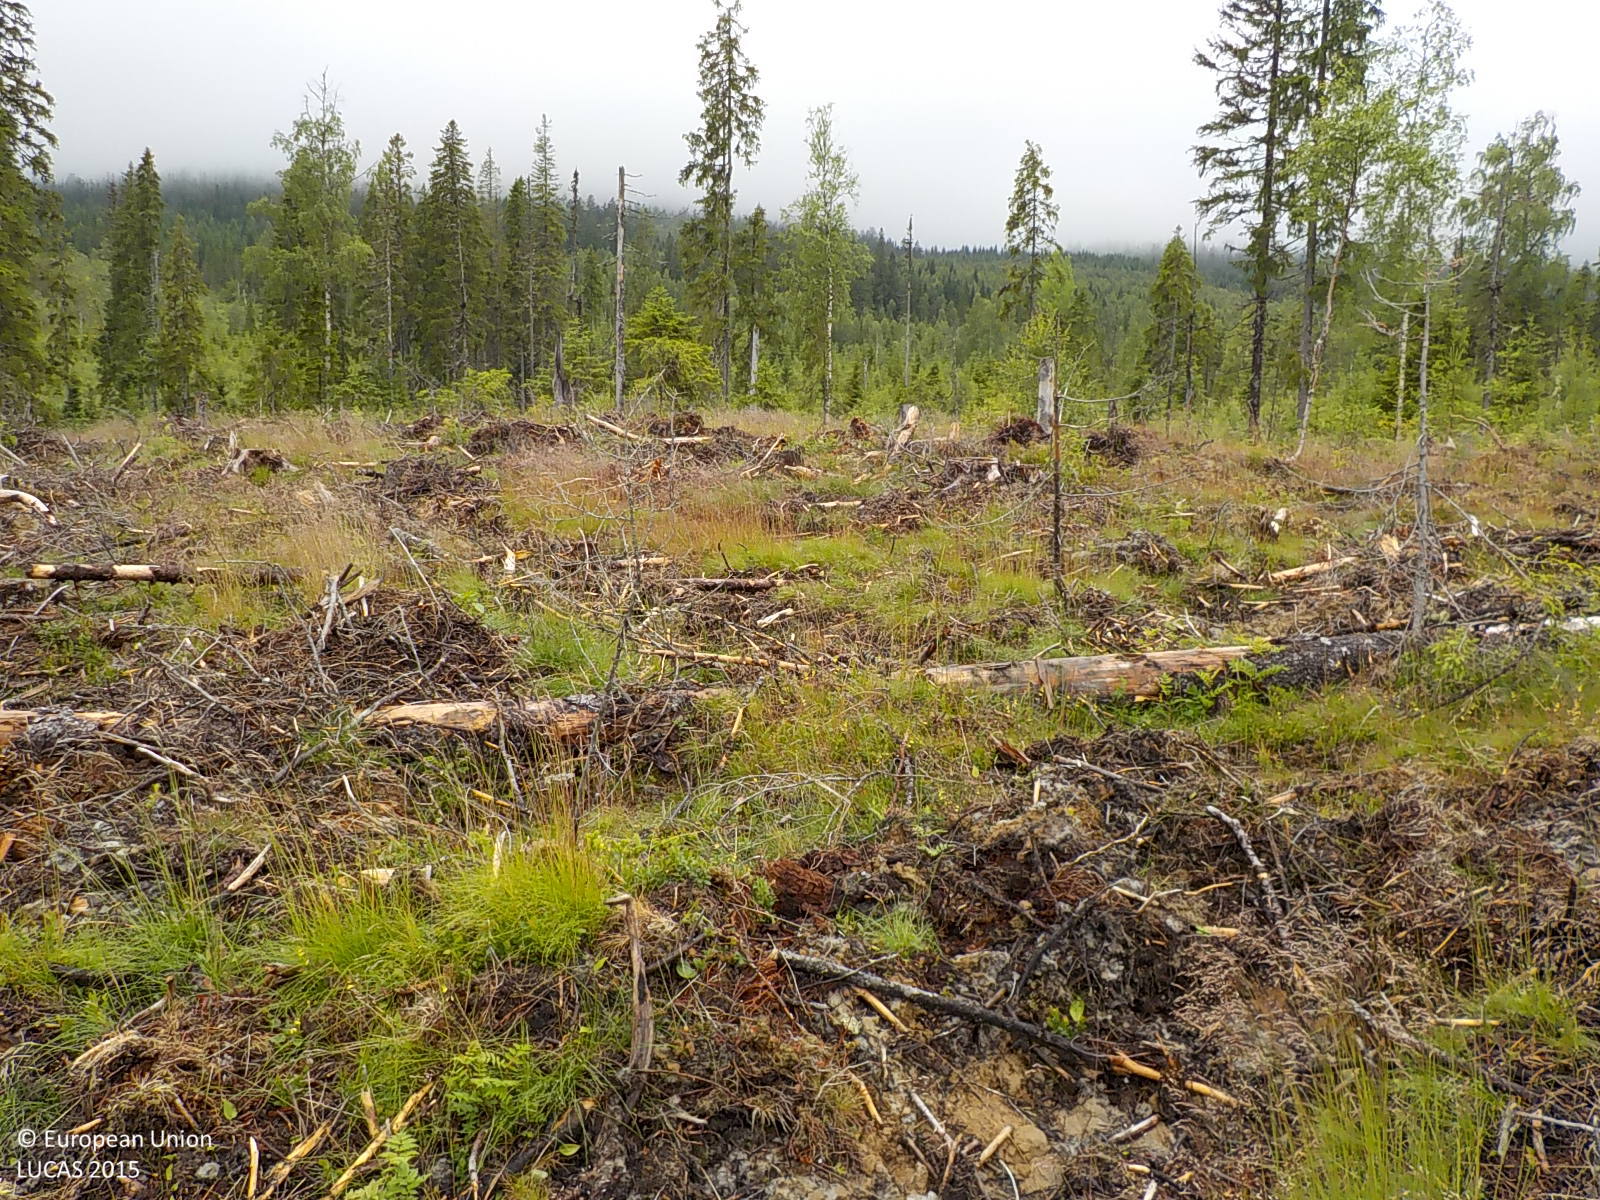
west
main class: Grassland
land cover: Grassland with sparse tree/shrub cover
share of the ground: 50 - 75 %
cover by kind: herbaceous plants 55 %, coniferous forest trees 5 %, shrubs 5 %, unconsolidated bare surface 5 %
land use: Forestry
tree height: < 5 m
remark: Clear cut
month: July
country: SE
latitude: 63.1437
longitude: 18.3312
